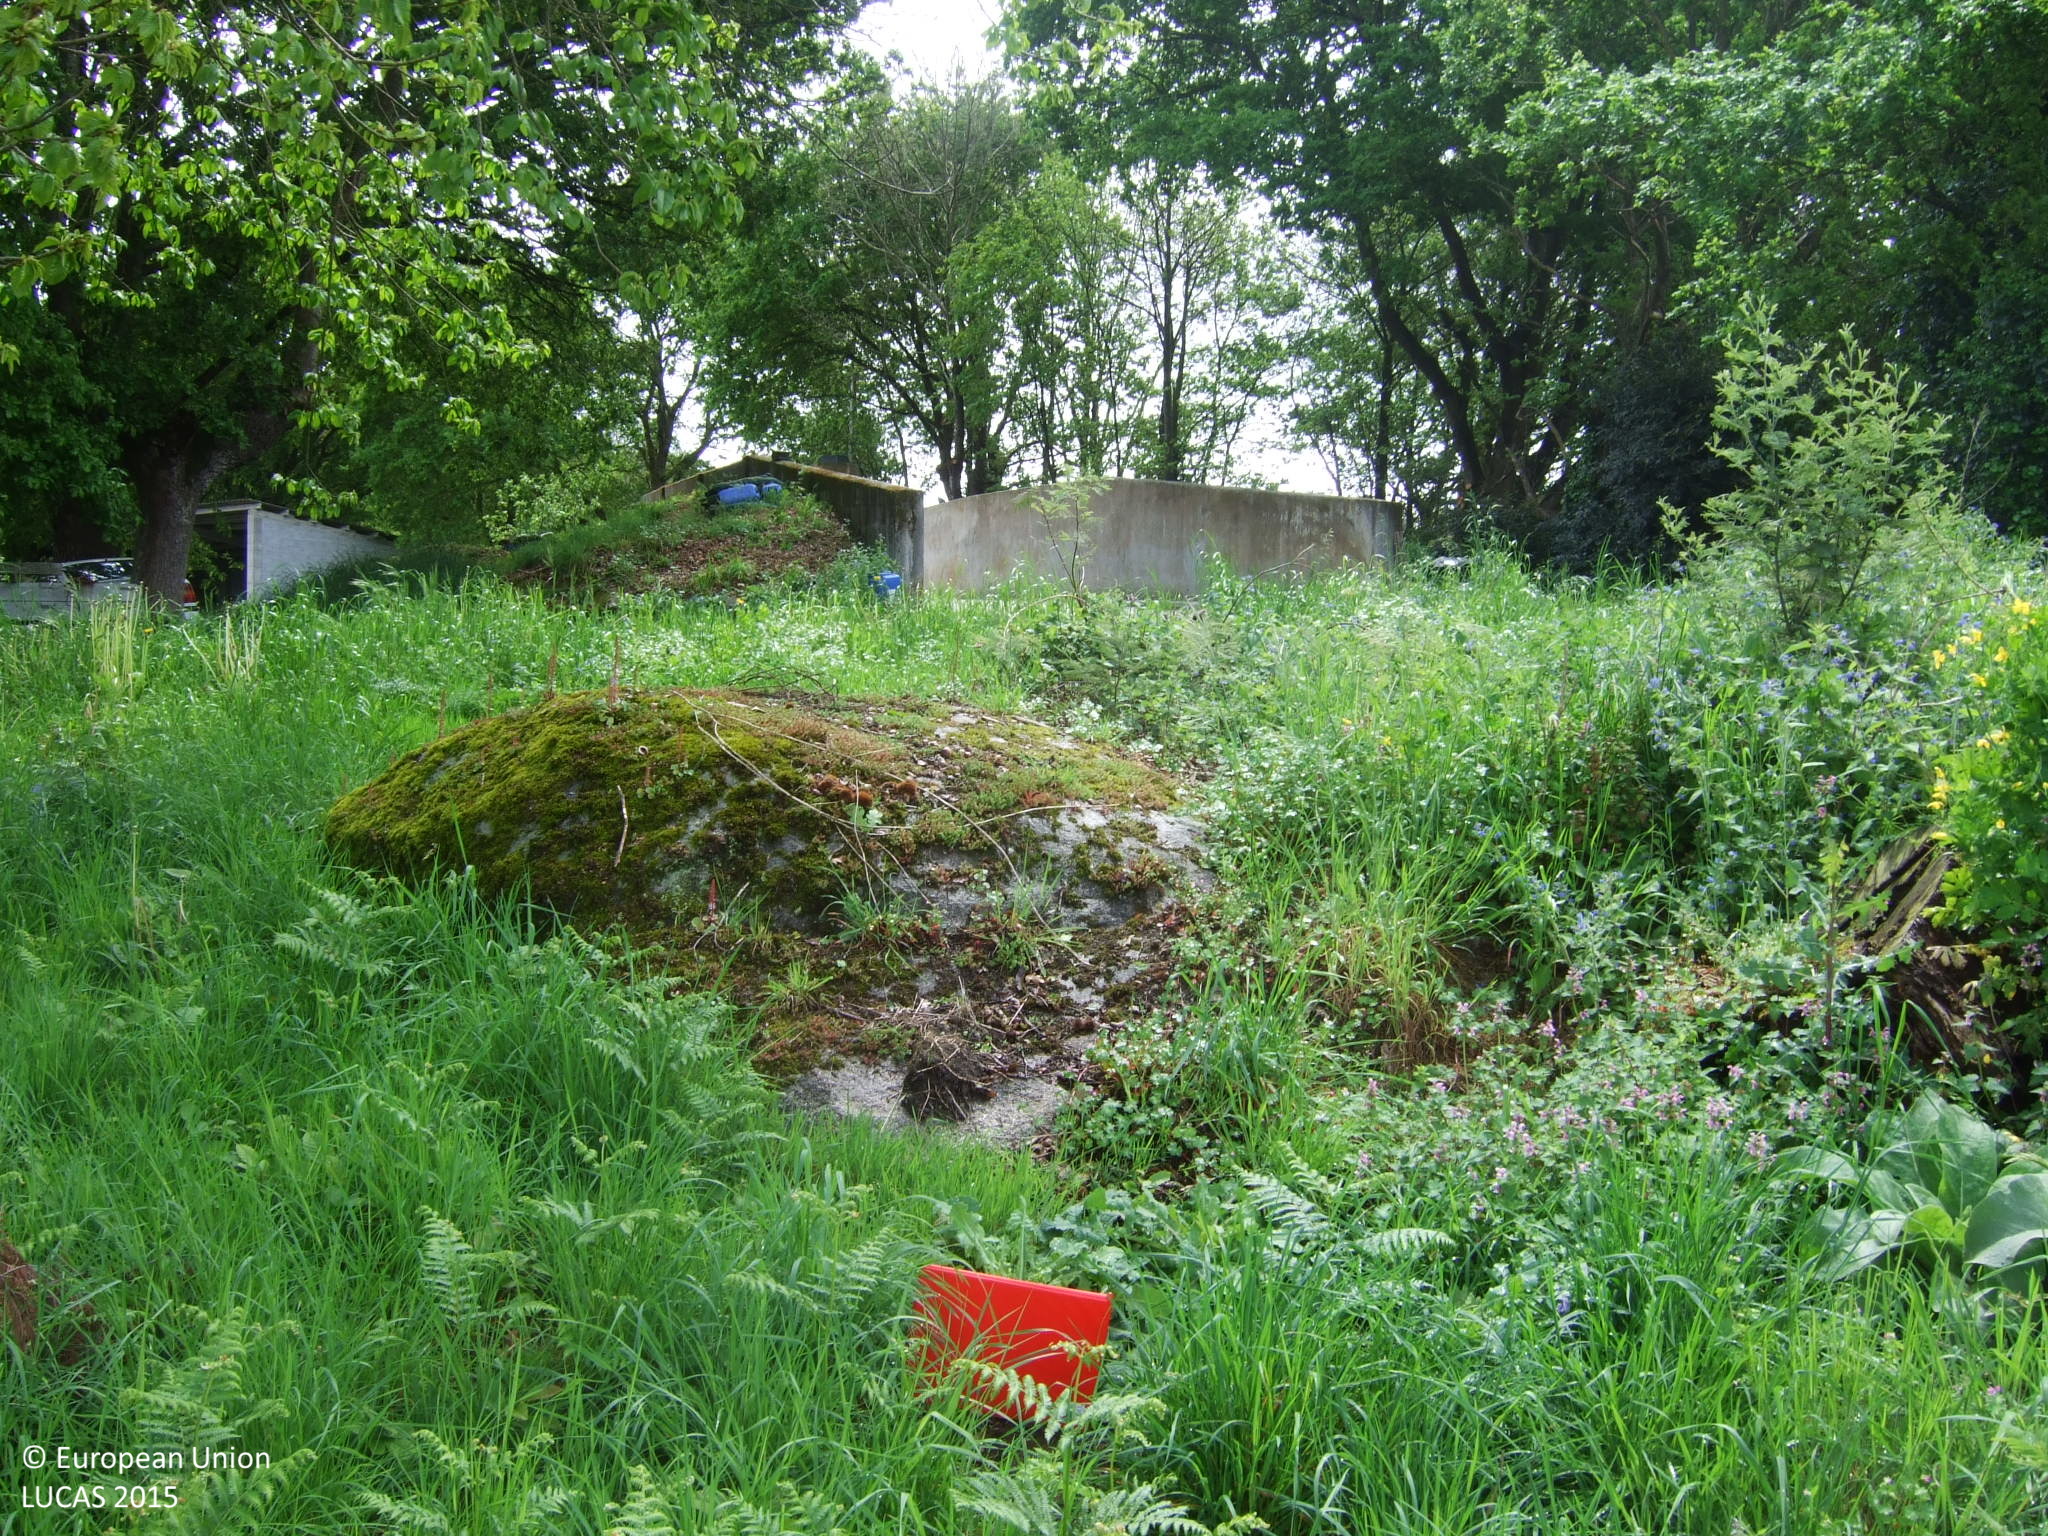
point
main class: Grassland
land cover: Grassland without tree/shrub cover
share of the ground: > 75 %
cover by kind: herbaceous plants 100 %
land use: Residential
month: May
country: ES
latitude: 42.8214
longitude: -7.5534
